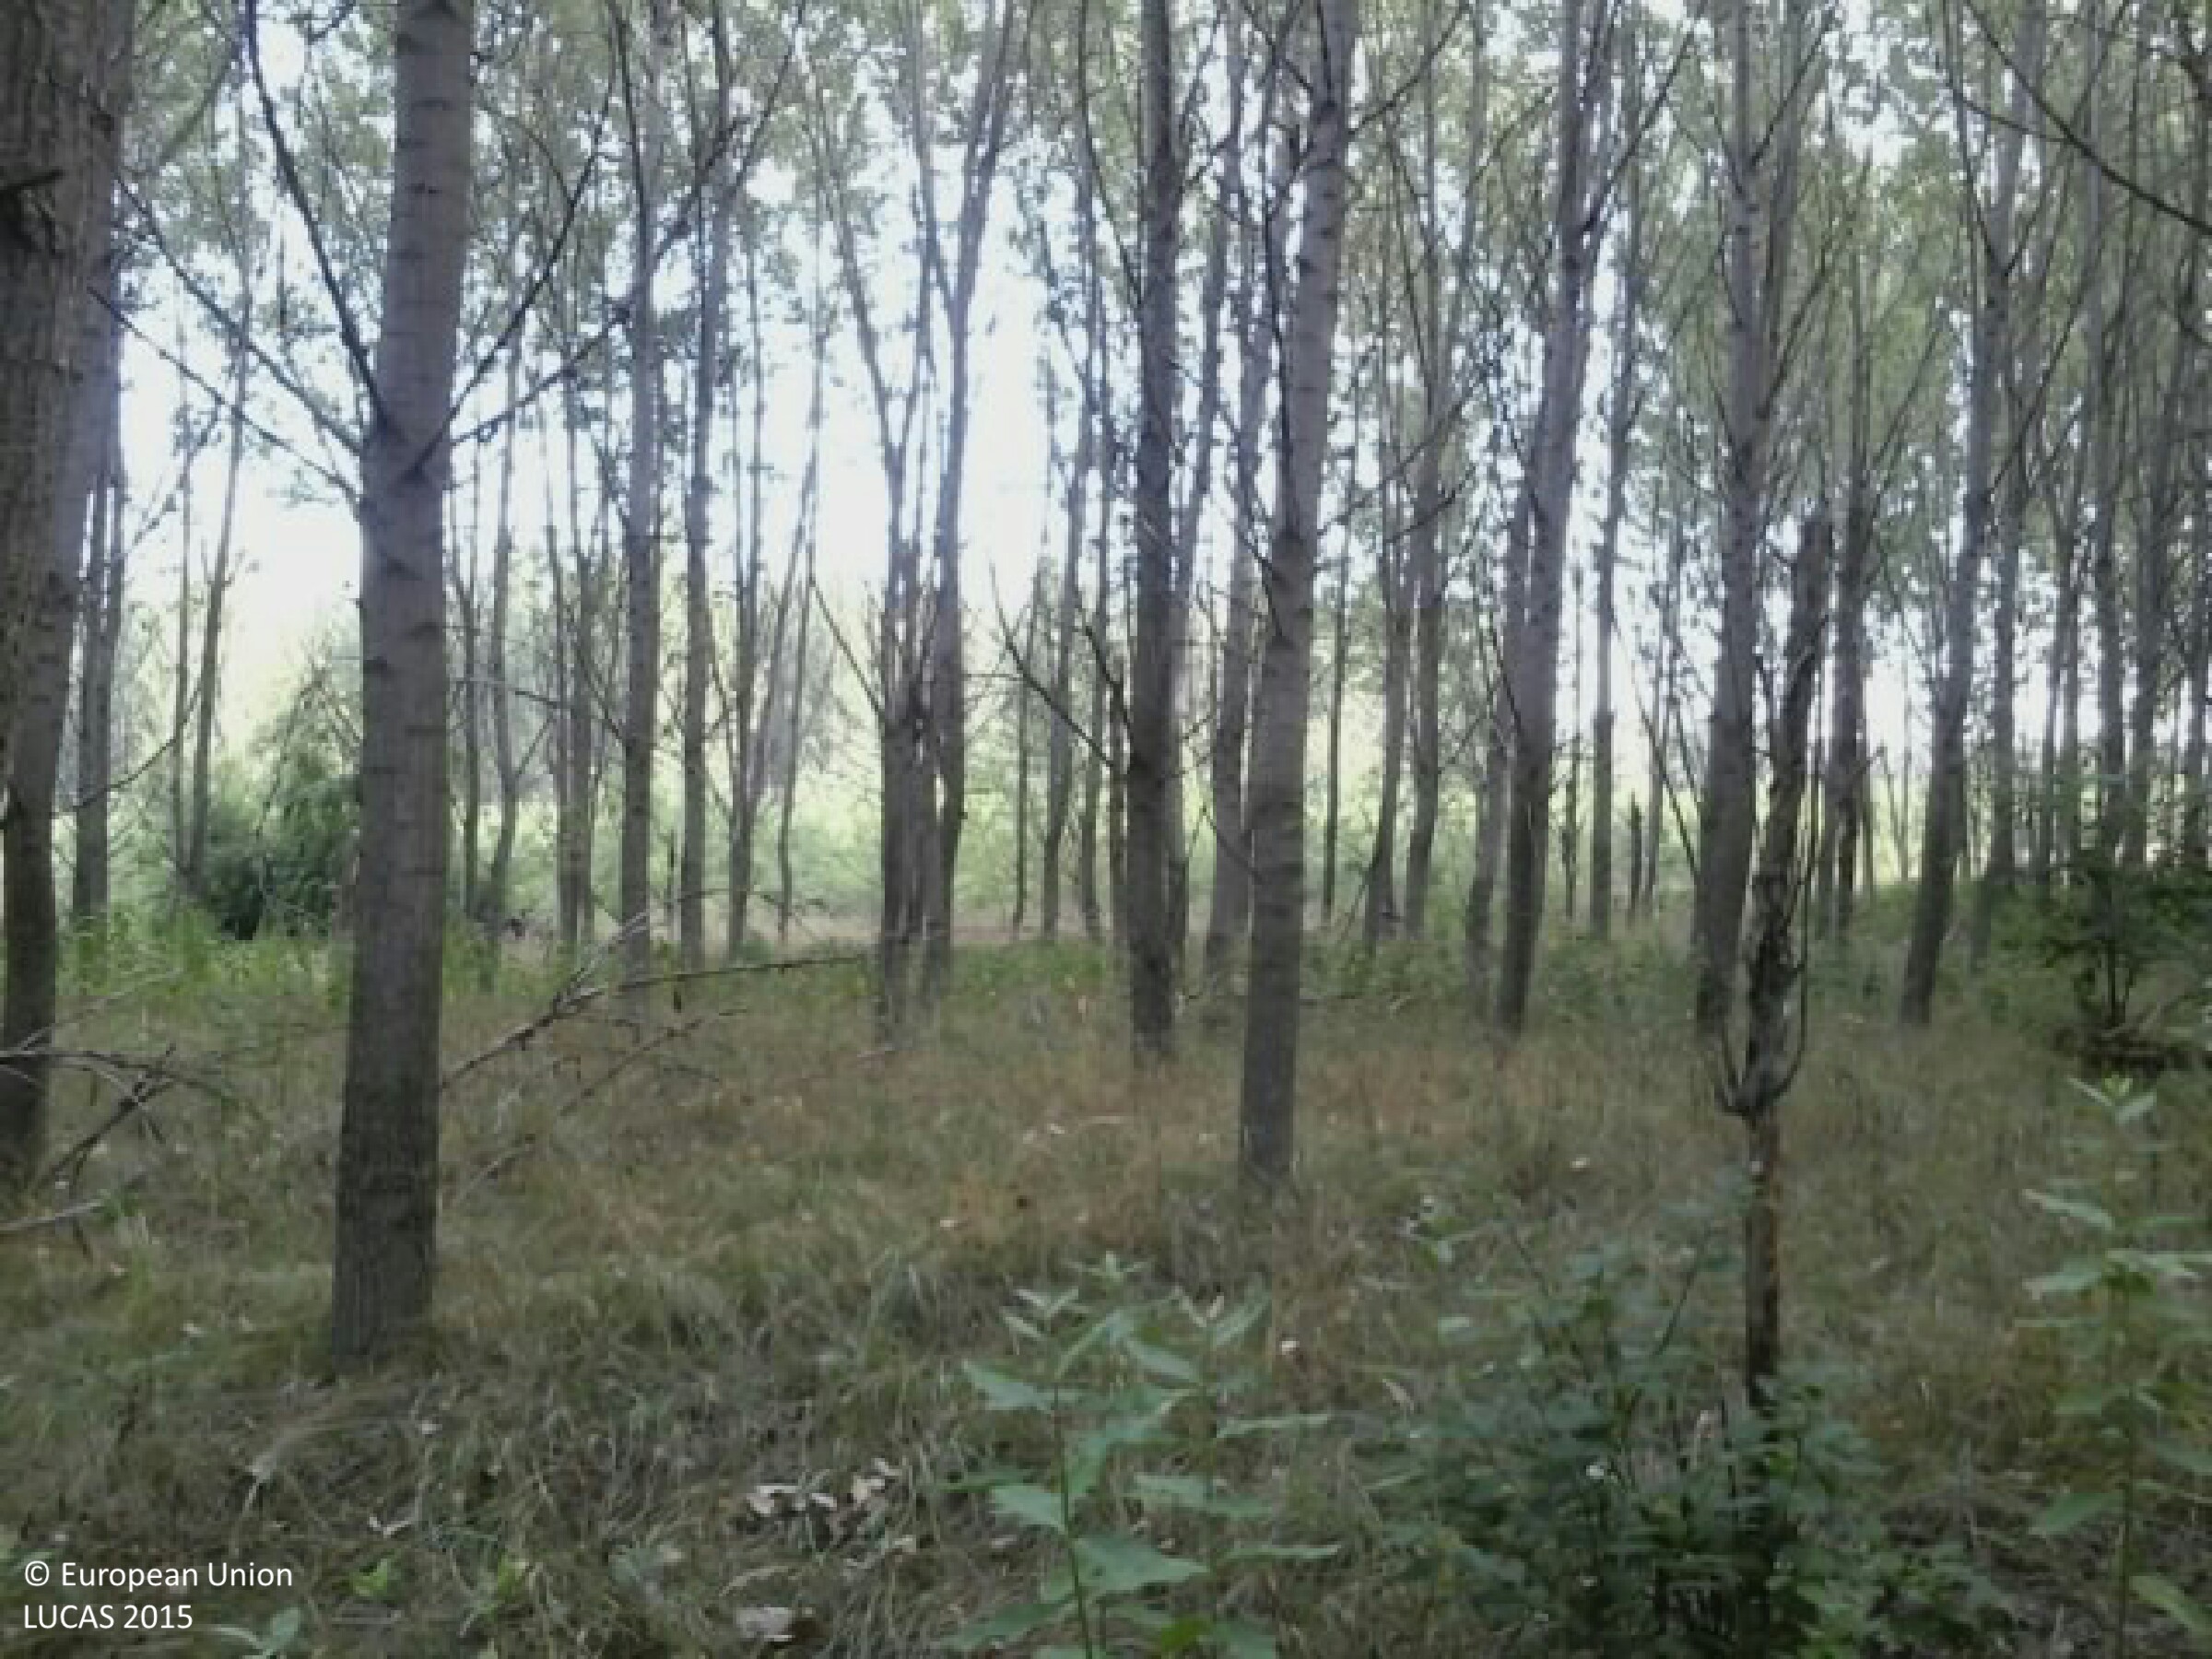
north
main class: Woodland
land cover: Broadleaved woodland
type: mesophytic deciduous forest
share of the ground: > 75 %
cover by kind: broadleaved forest trees 85 %, herbaceous plants 15 %
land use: Forestry
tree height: > 5 m
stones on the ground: < 10 %
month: August
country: HU
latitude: 47.0140
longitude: 19.7163
